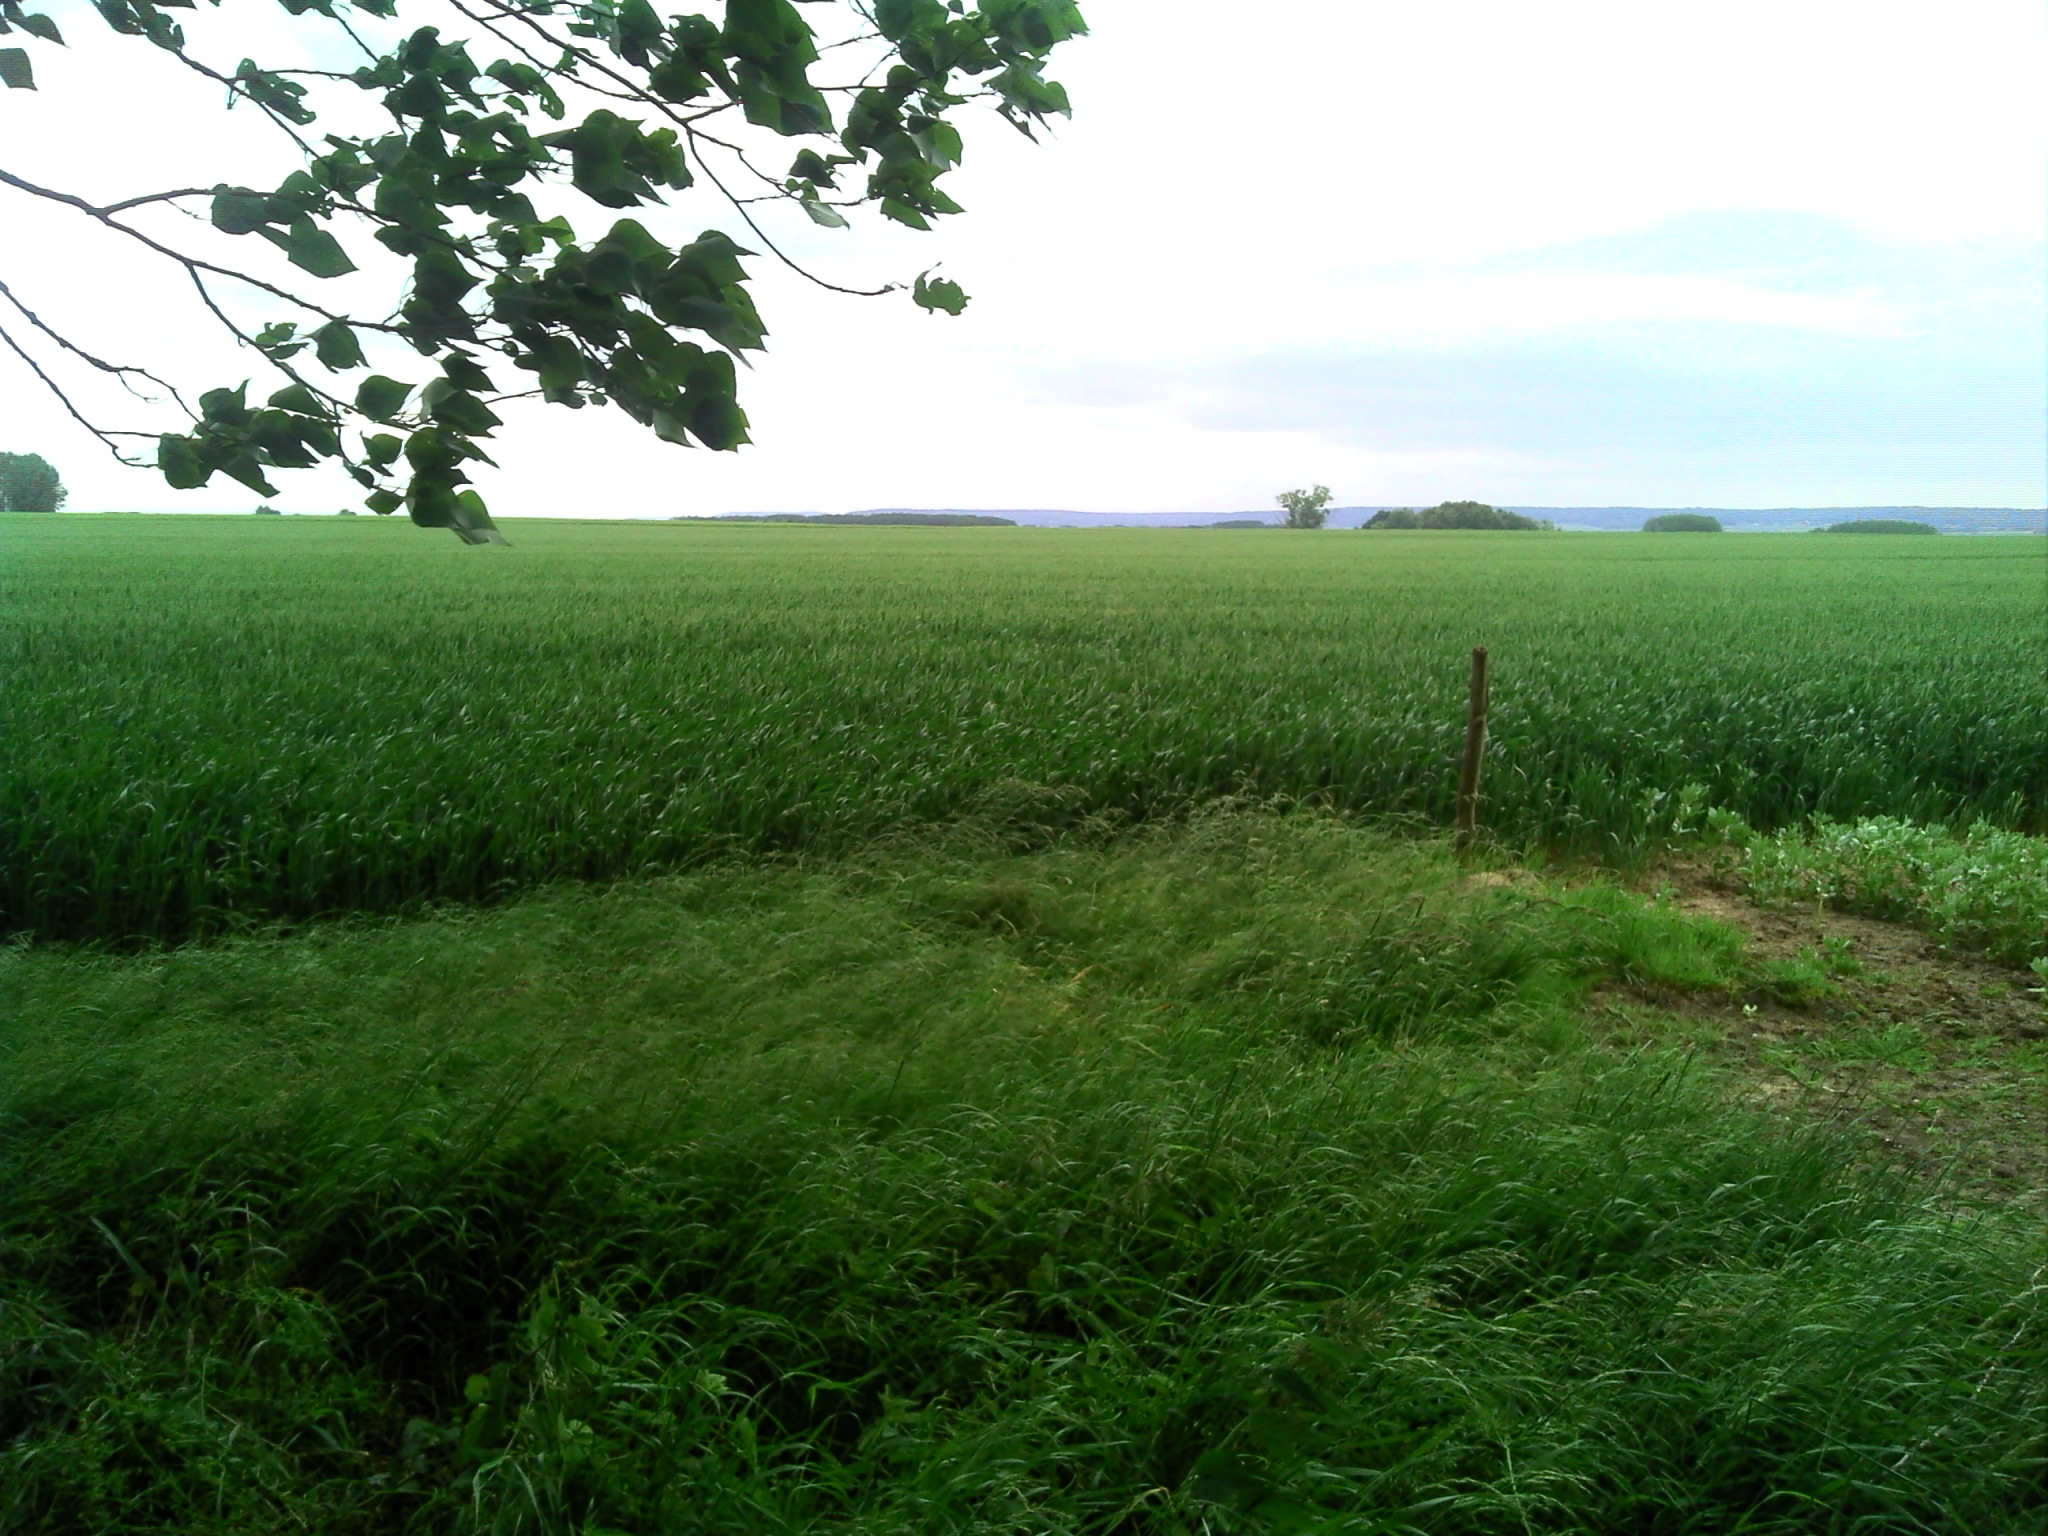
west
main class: Woodland
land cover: Broadleaved woodland
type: exotic forest
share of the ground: > 75 %
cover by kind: broadleaved forest trees 90 %, shrubs 10 %
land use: Forestry
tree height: > 5 m
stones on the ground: < 10 %
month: June
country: FR
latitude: 49.5858
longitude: 3.2276
